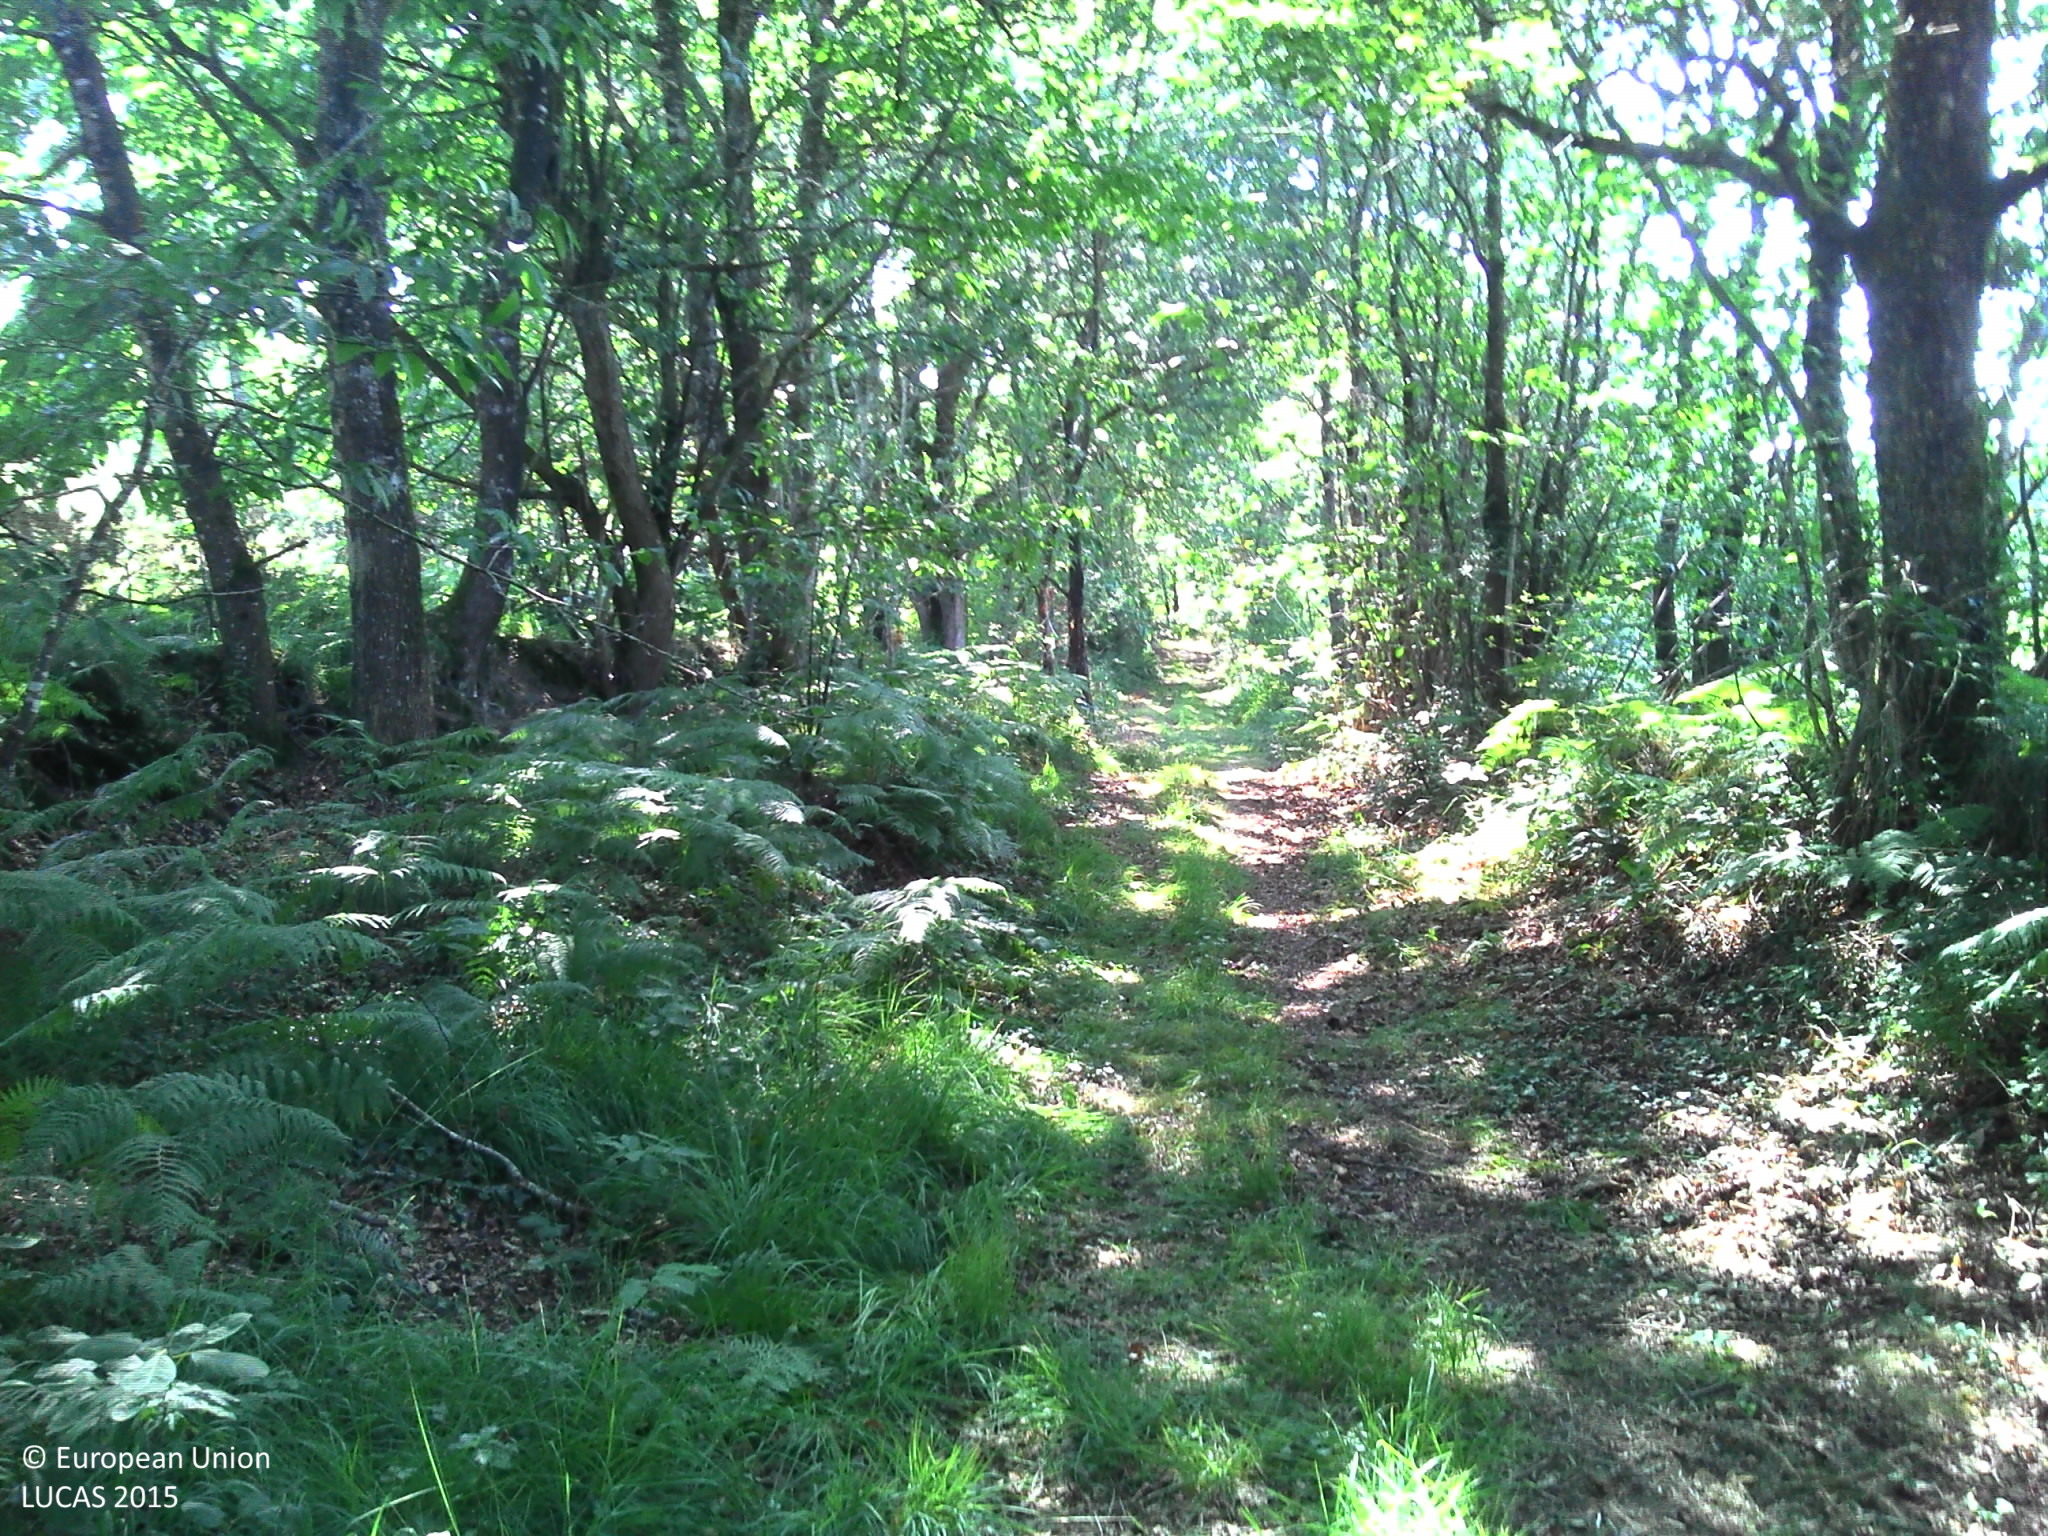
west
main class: Shrubland
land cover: Shrubland with sparse tree cover
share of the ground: > 75 %
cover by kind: shrubs 75 %, herbaceous plants 20 %, broadleaved forest trees 5 %
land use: Forestry
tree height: > 5 m
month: August
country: FR
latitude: 43.7152
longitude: -0.7740
